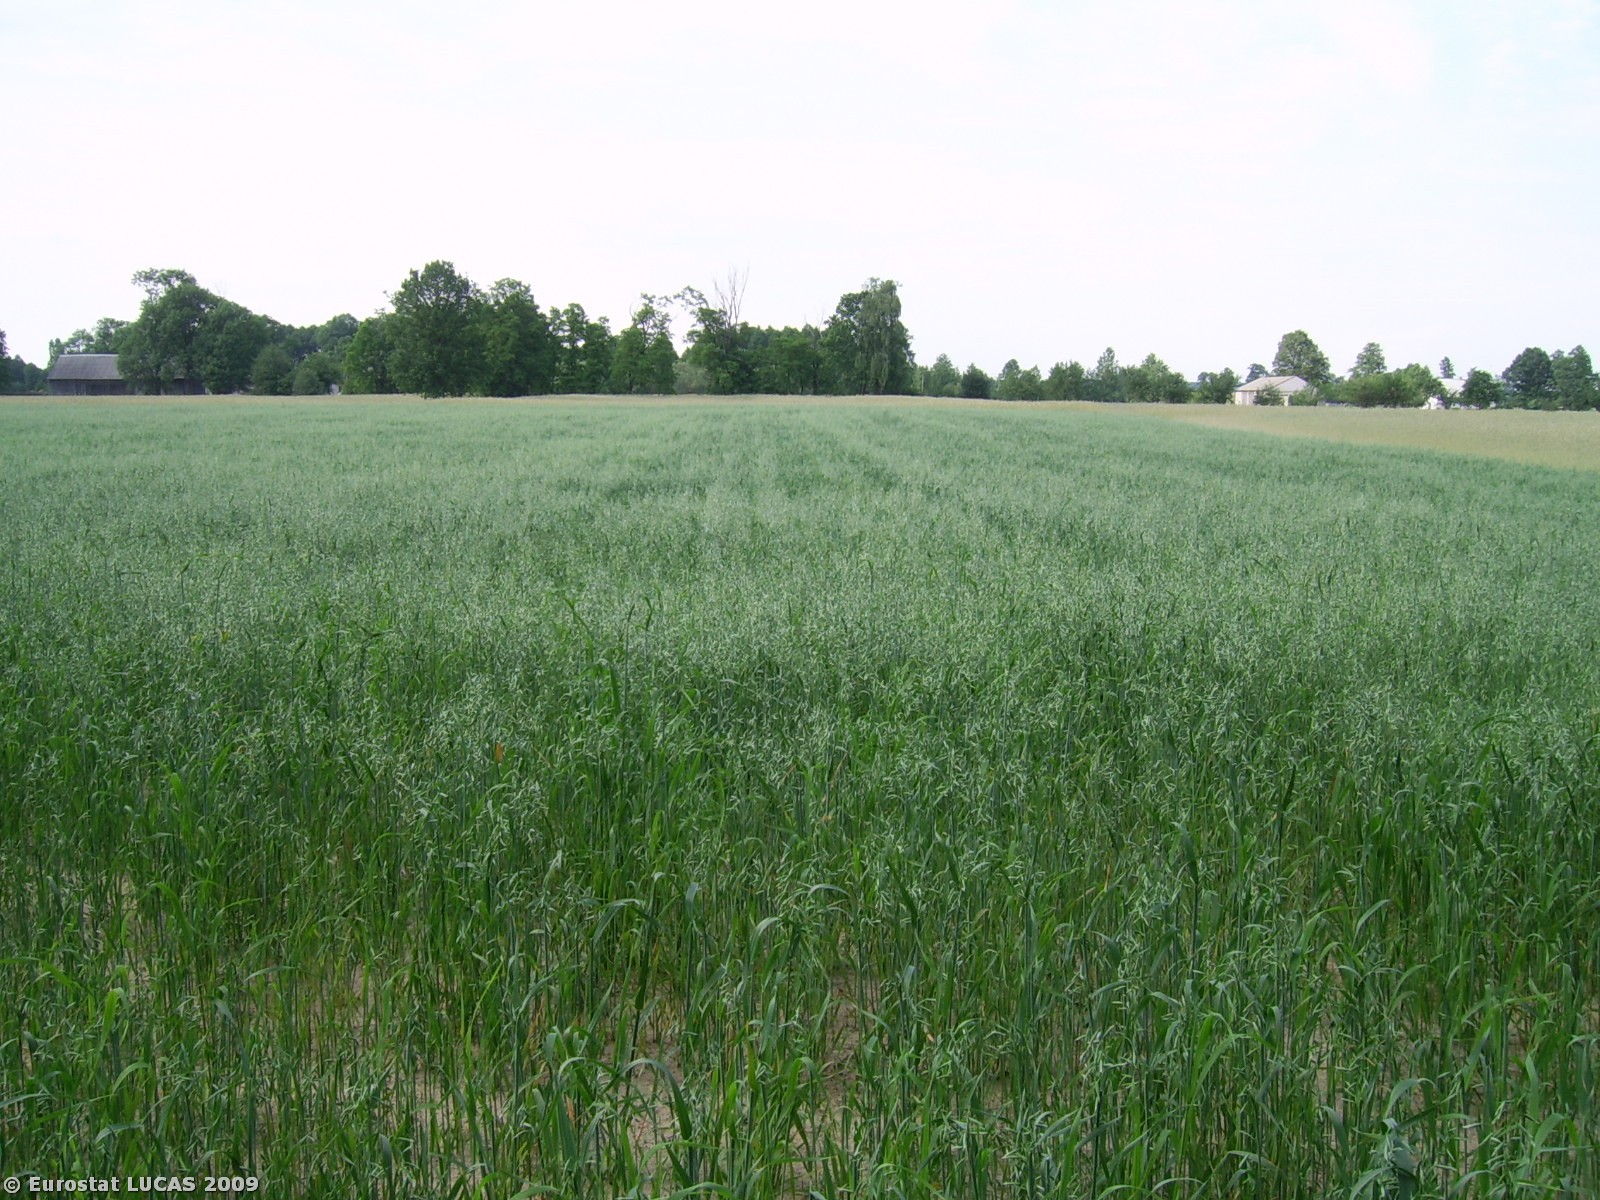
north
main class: Cropland
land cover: Oats
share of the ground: > 75 %
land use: Agriculture (excluding fallow land and kitchen gardens)
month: June
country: PL
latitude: 52.1029
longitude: 17.7959
